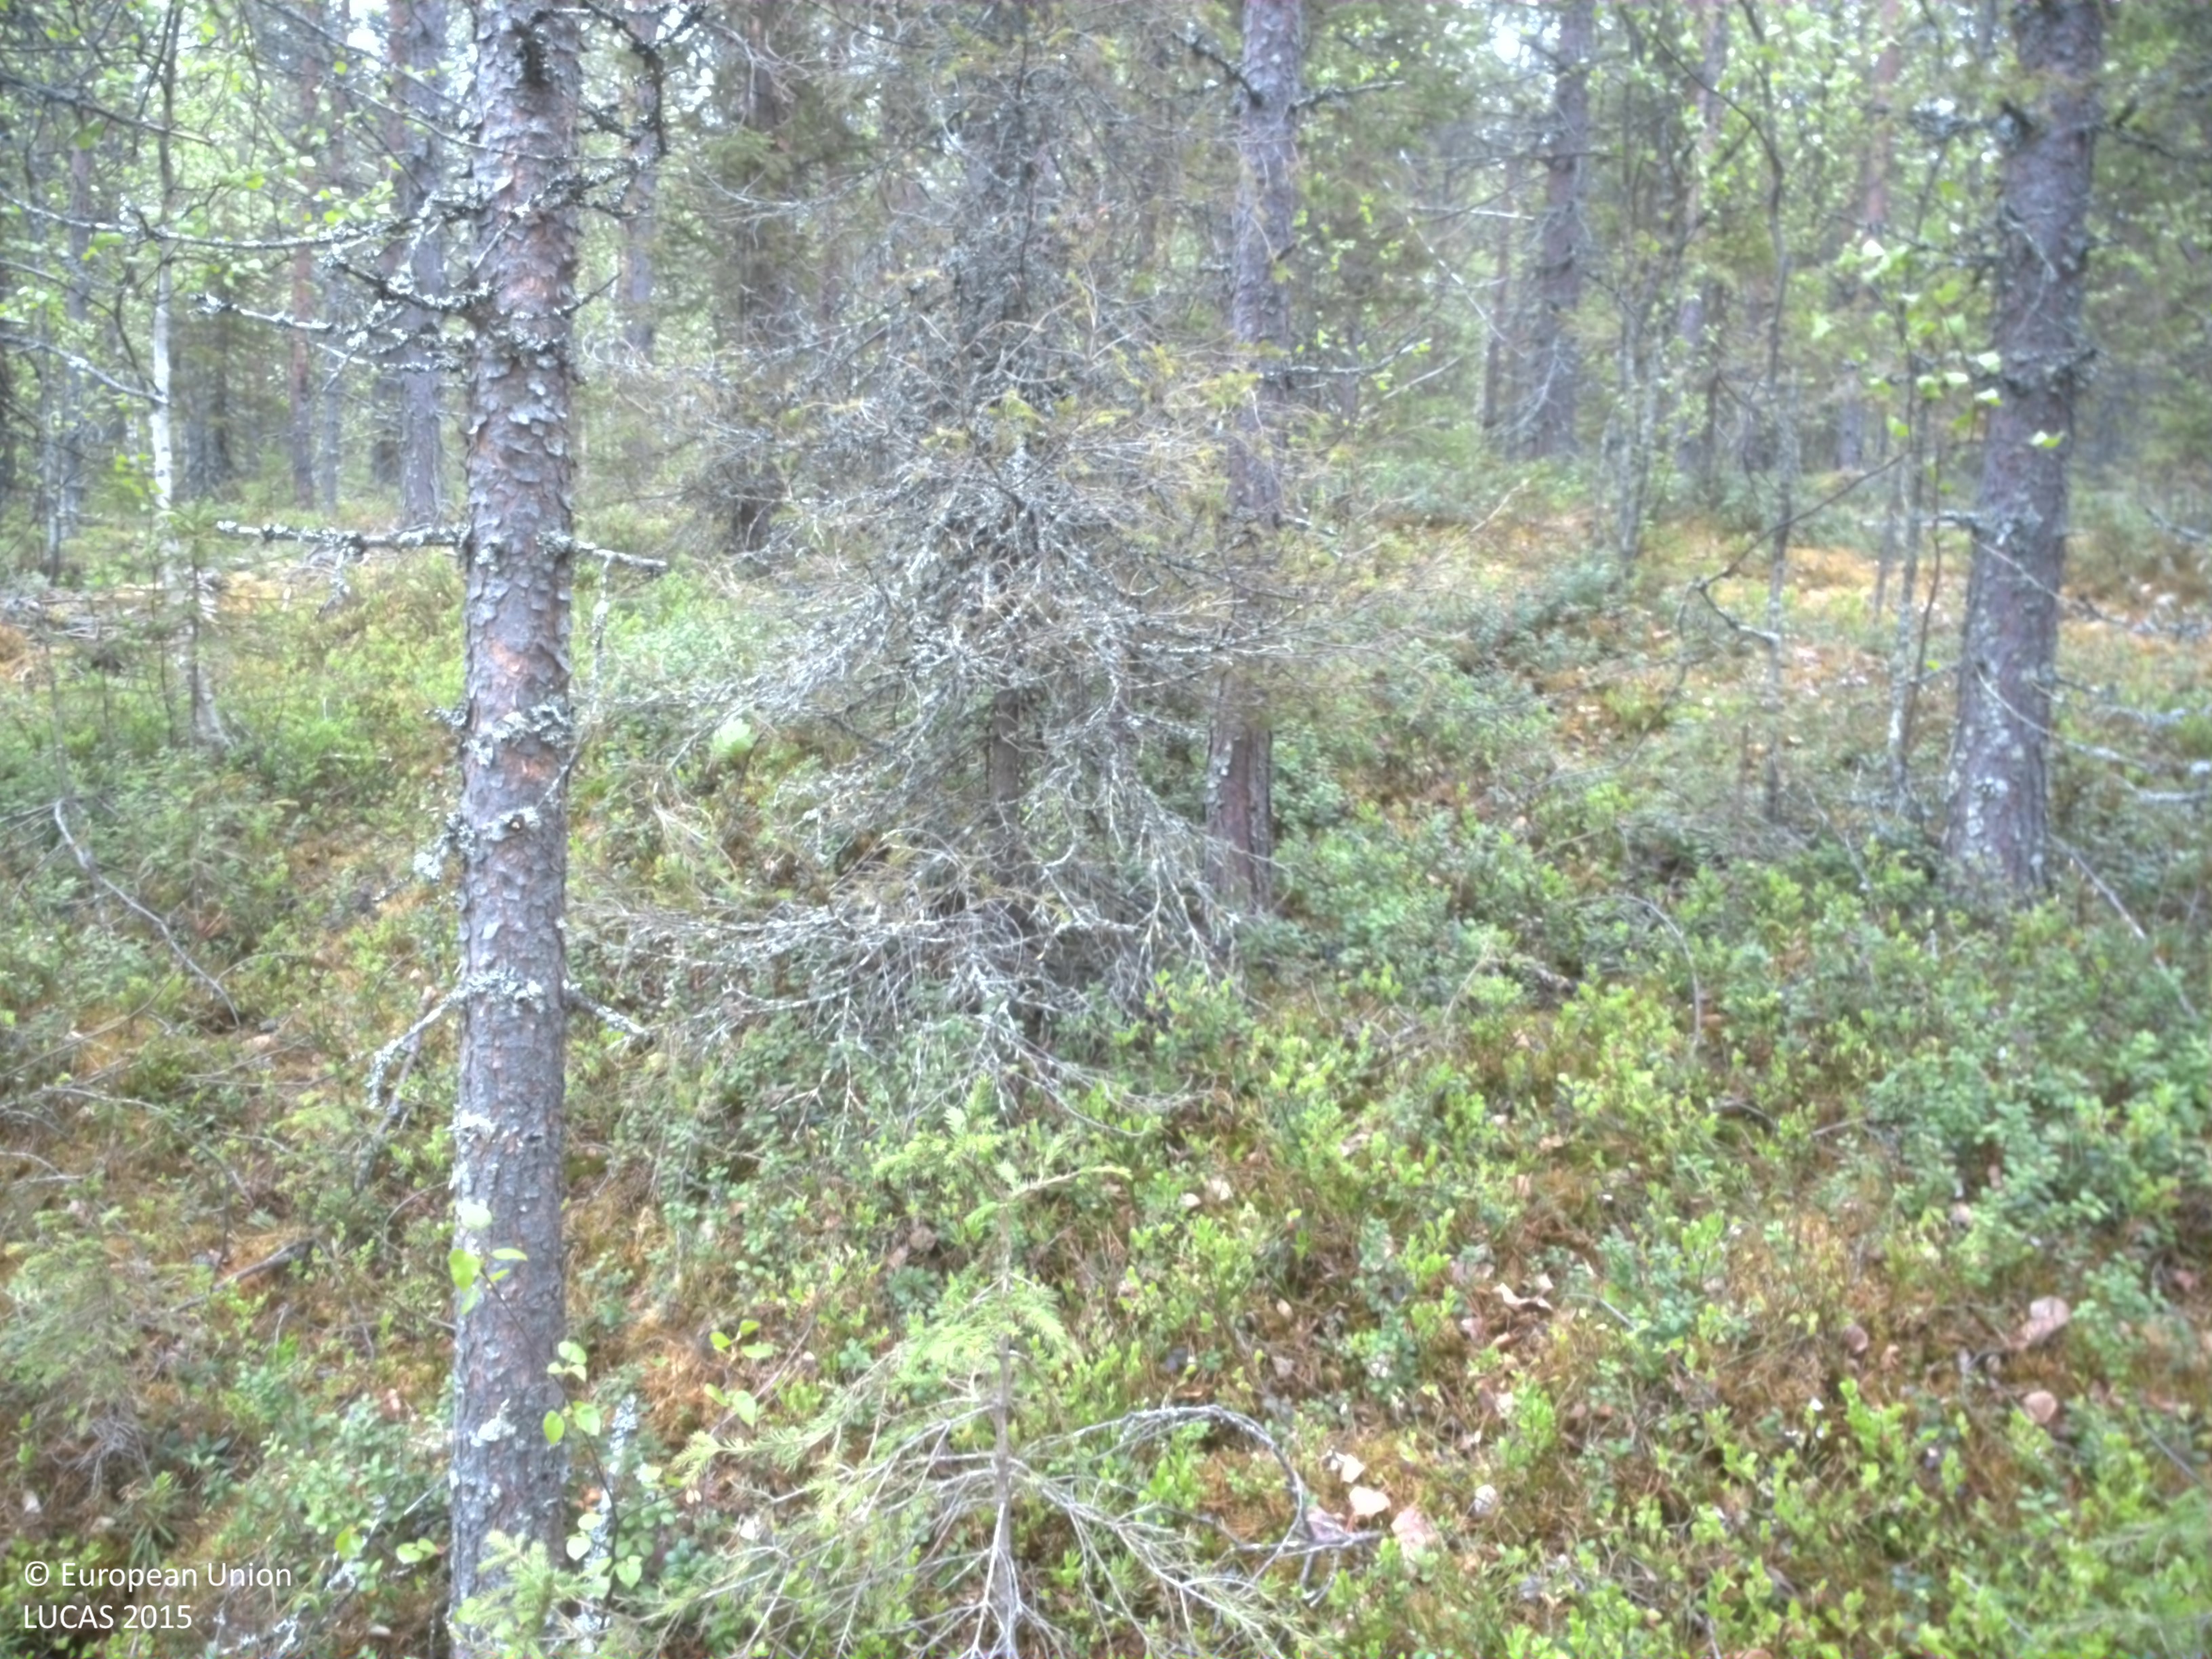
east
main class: Woodland
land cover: Pine dominated mixed woodland
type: boreal forest
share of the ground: 25 - 50 %
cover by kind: herbaceous plants 40 %, coniferous forest trees 25 %, lichens and mosses 15 %, broadleaved forest trees 10 %, shrubs 10 %
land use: Forestry
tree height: > 5 m
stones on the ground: < 10 %
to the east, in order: Pine dominated mixed woodland; Groves; Ditches and canals; Paved roads, cycling and walking lanes; Ditches and canals; Pine dominated mixed woodland; Other mixed woodland; Spruce dominated mixed woodland; Pine dominated mixed woodland; Spruce dominated mixed woodland; Other mixed woodland
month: June
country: SE
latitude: 66.6990
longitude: 22.4056
